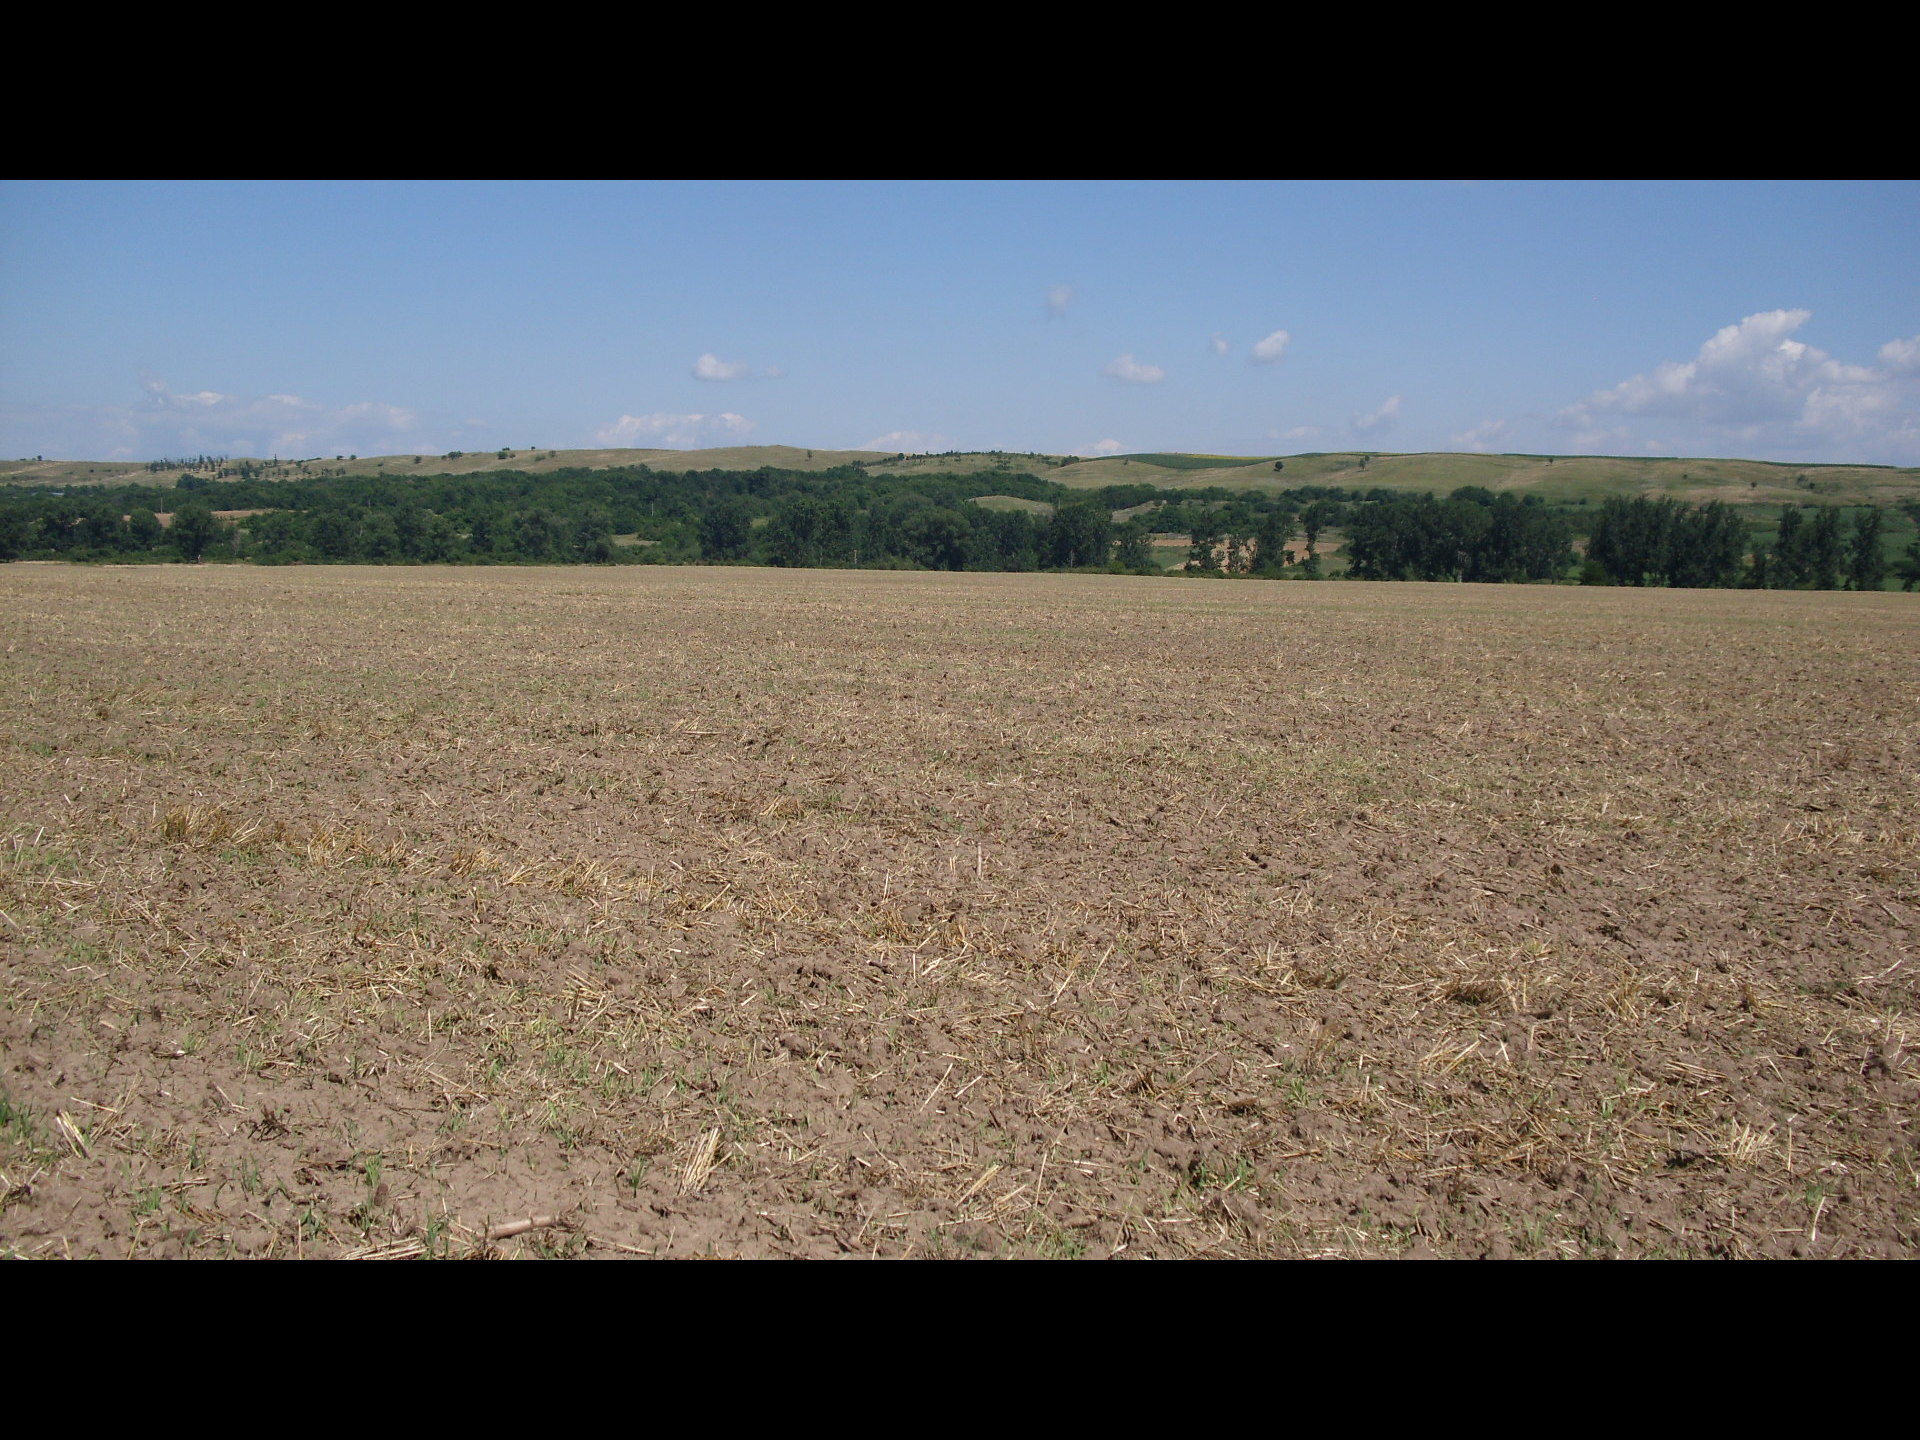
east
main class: Cropland
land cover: Barley
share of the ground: > 75 %
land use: Agriculture (excluding fallow land and kitchen gardens)
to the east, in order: Barley
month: July
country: BG
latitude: 43.7241
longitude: 23.4651
